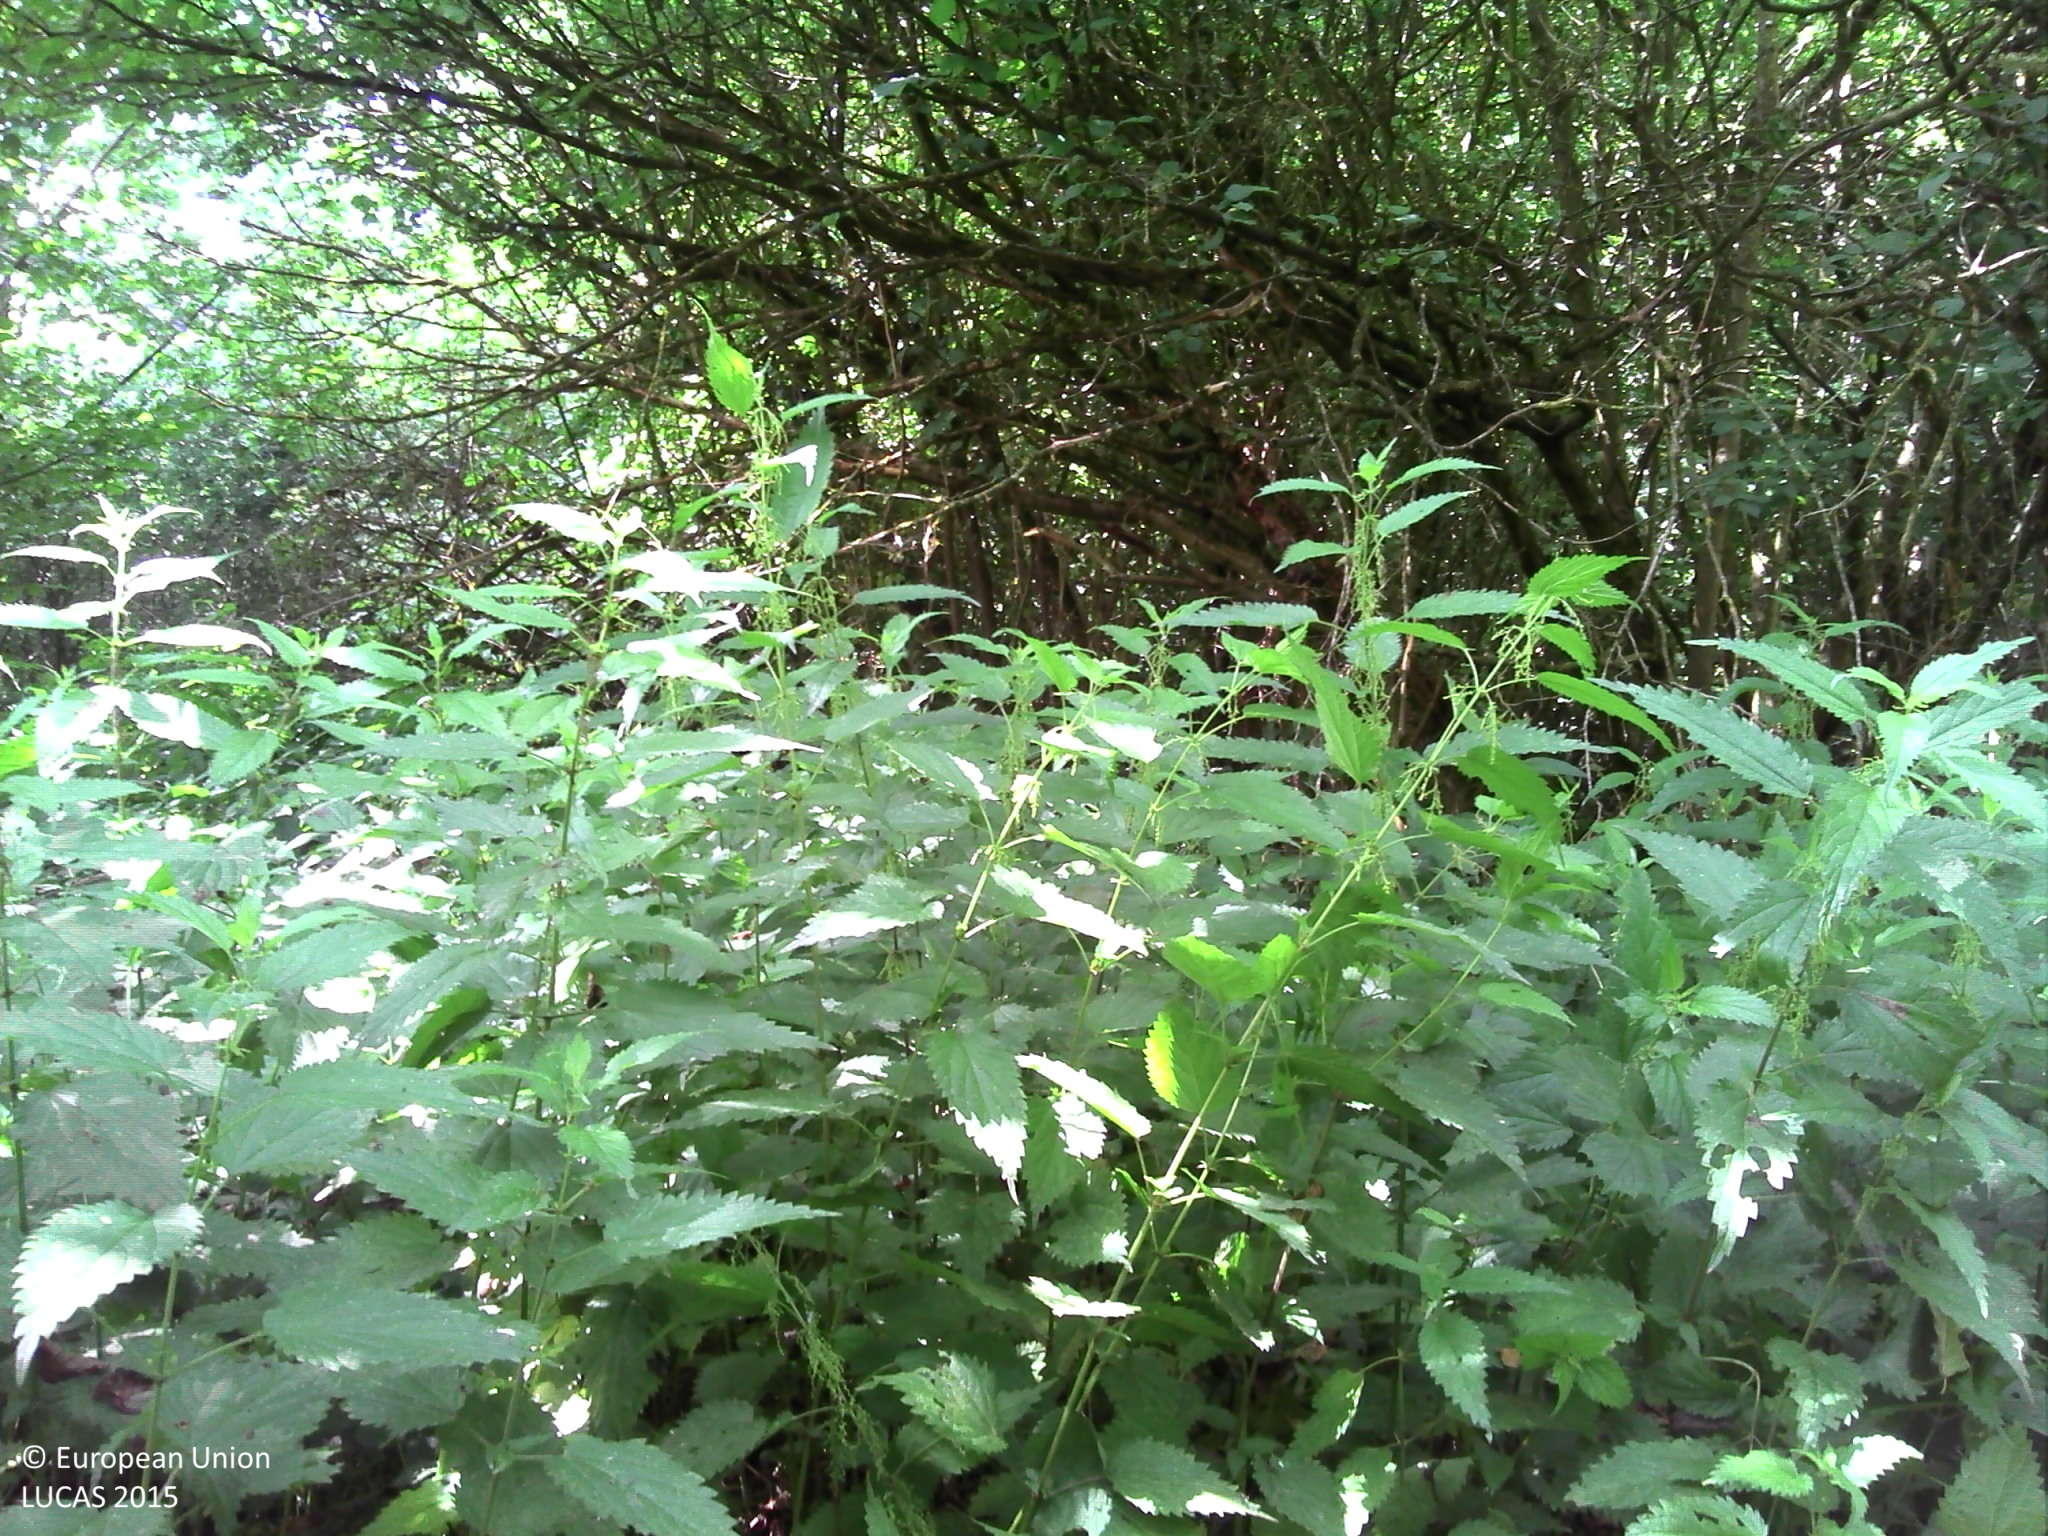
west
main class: Woodland
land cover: Broadleaved woodland
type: floodplain forest
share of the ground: > 75 %
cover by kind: broadleaved forest trees 95 %, herbaceous plants 5 %
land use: Forestry
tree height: > 5 m
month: July
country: BE
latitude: 50.2750
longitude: 4.6503
